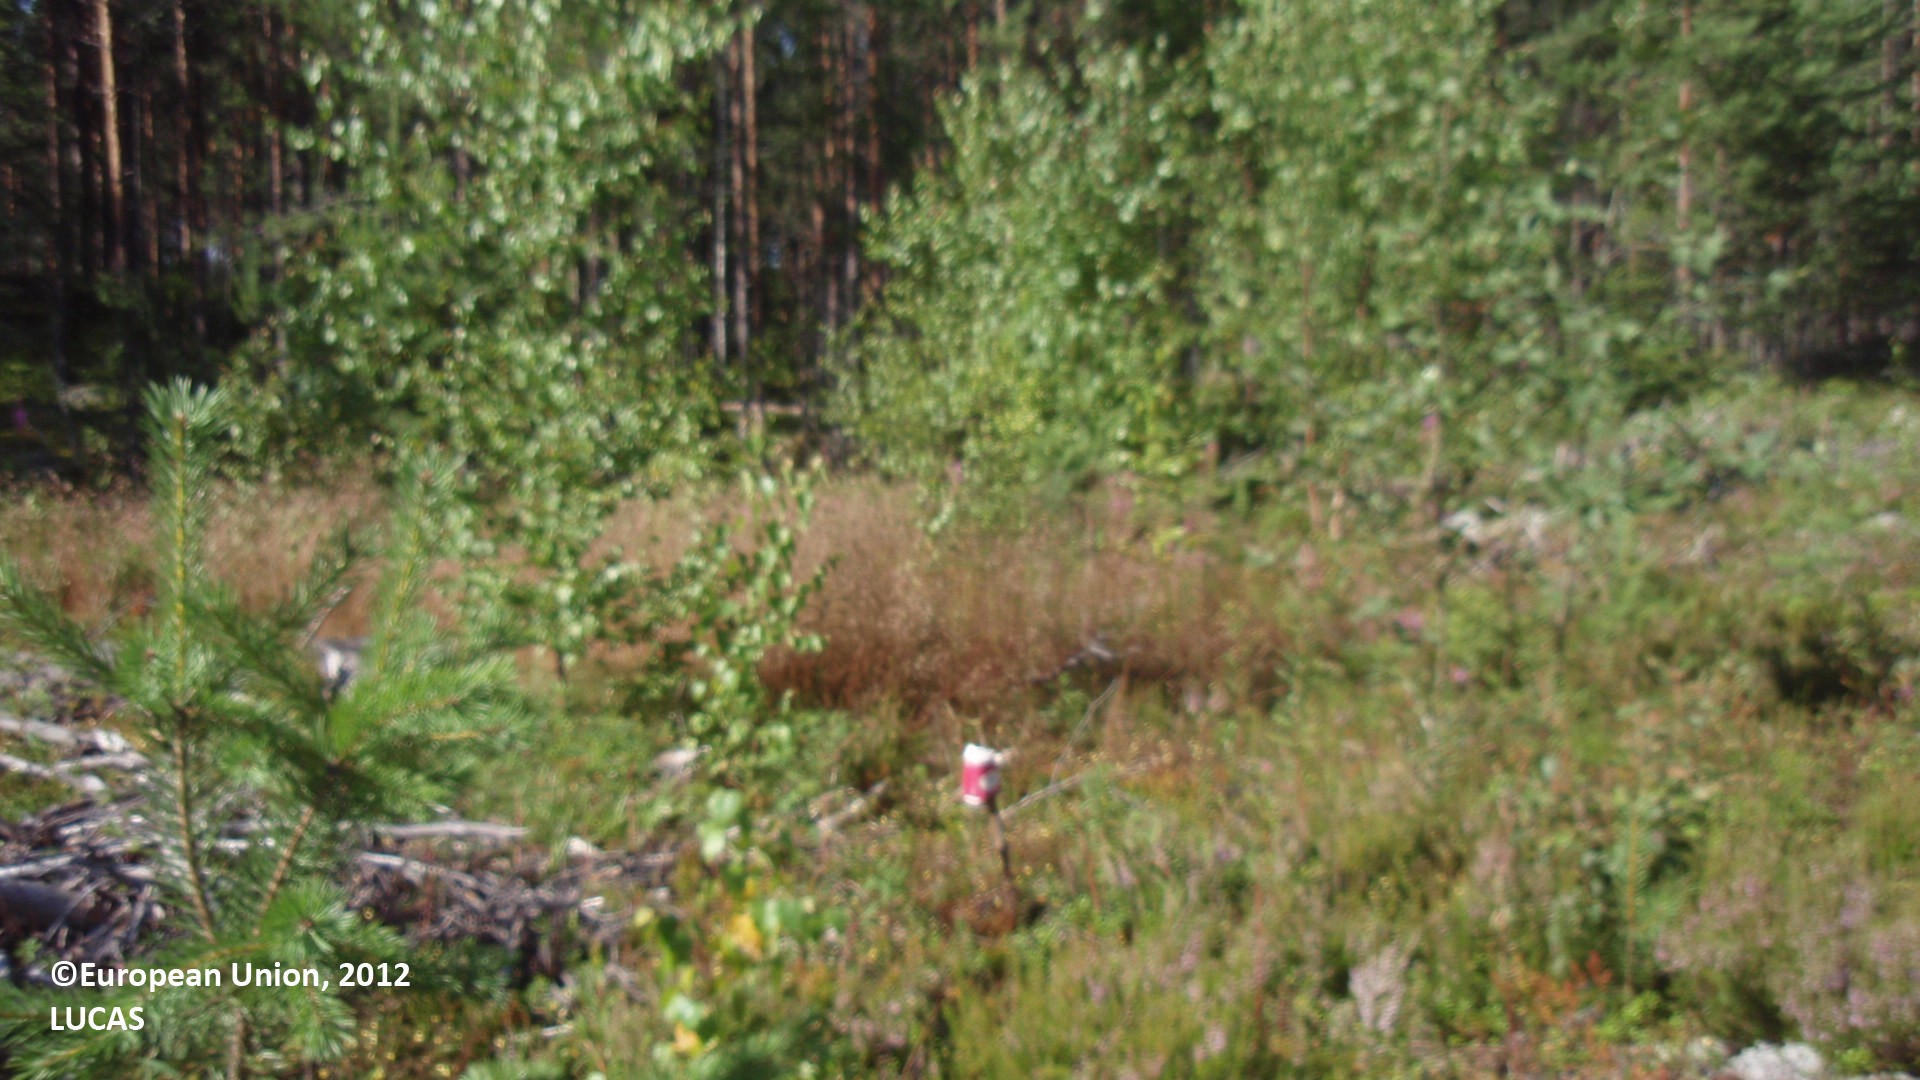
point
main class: Grassland
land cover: Grassland with sparse tree/shrub cover
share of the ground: > 75 %
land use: Forestry
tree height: > 5 m
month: July
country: FI
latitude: 61.4212
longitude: 28.1332
